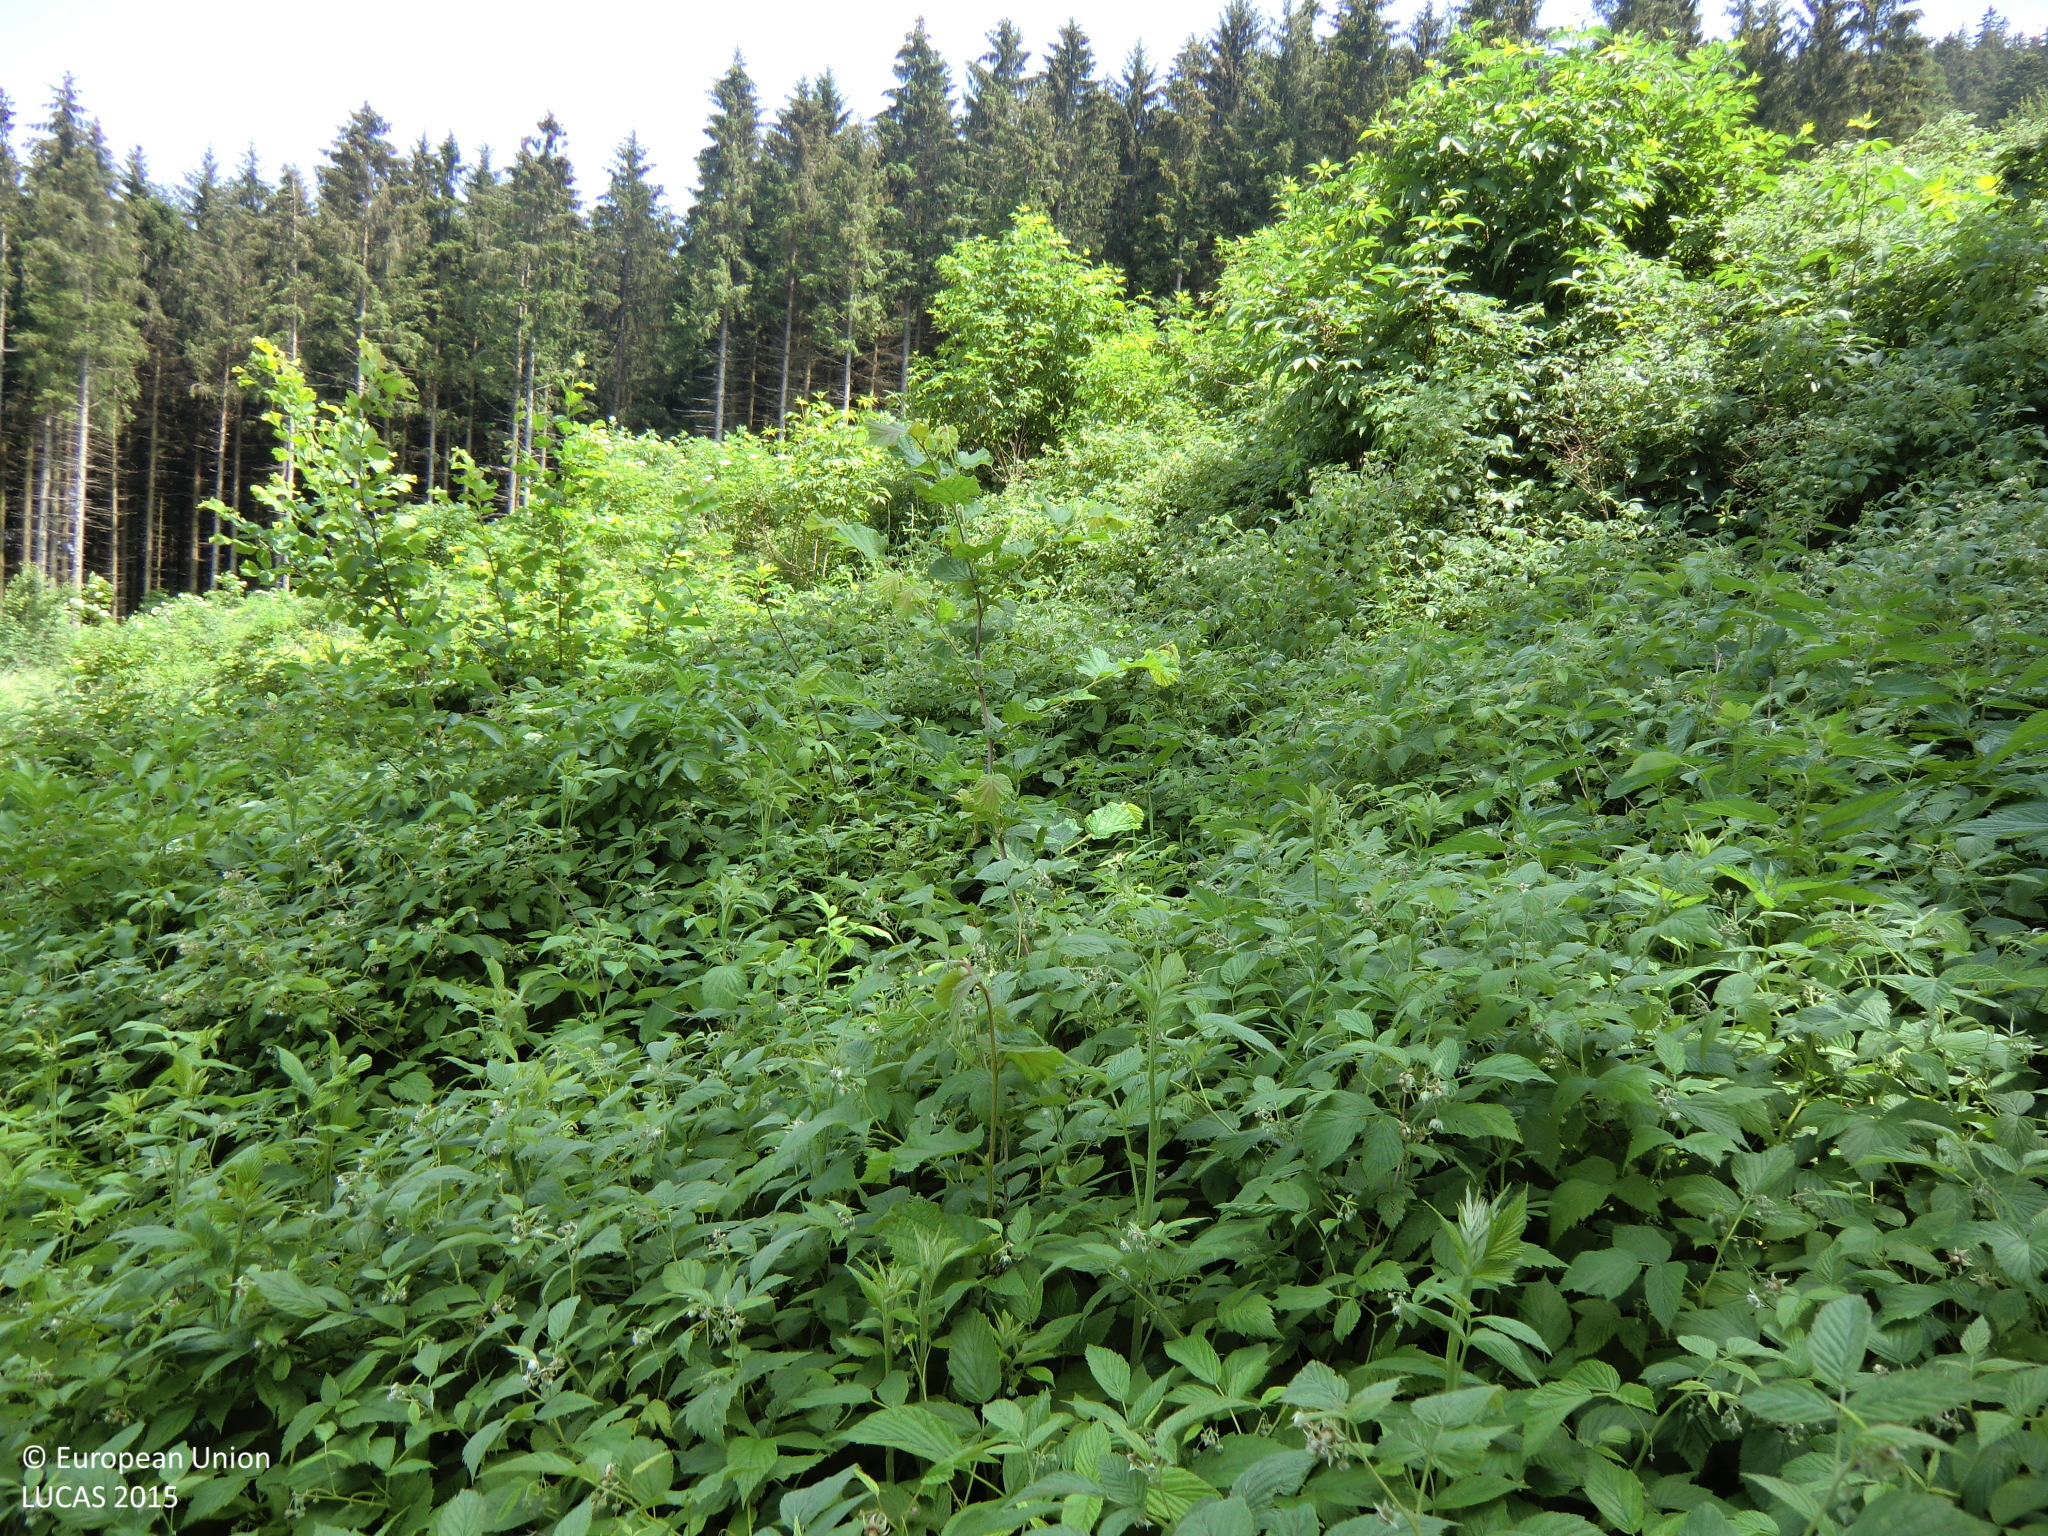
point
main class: Shrubland
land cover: Shrubland without tree cover
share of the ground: > 75 %
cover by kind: herbaceous plants 80 %, shrubs 20 %
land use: Forestry
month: June
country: AT
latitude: 48.3908
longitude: 14.7682
